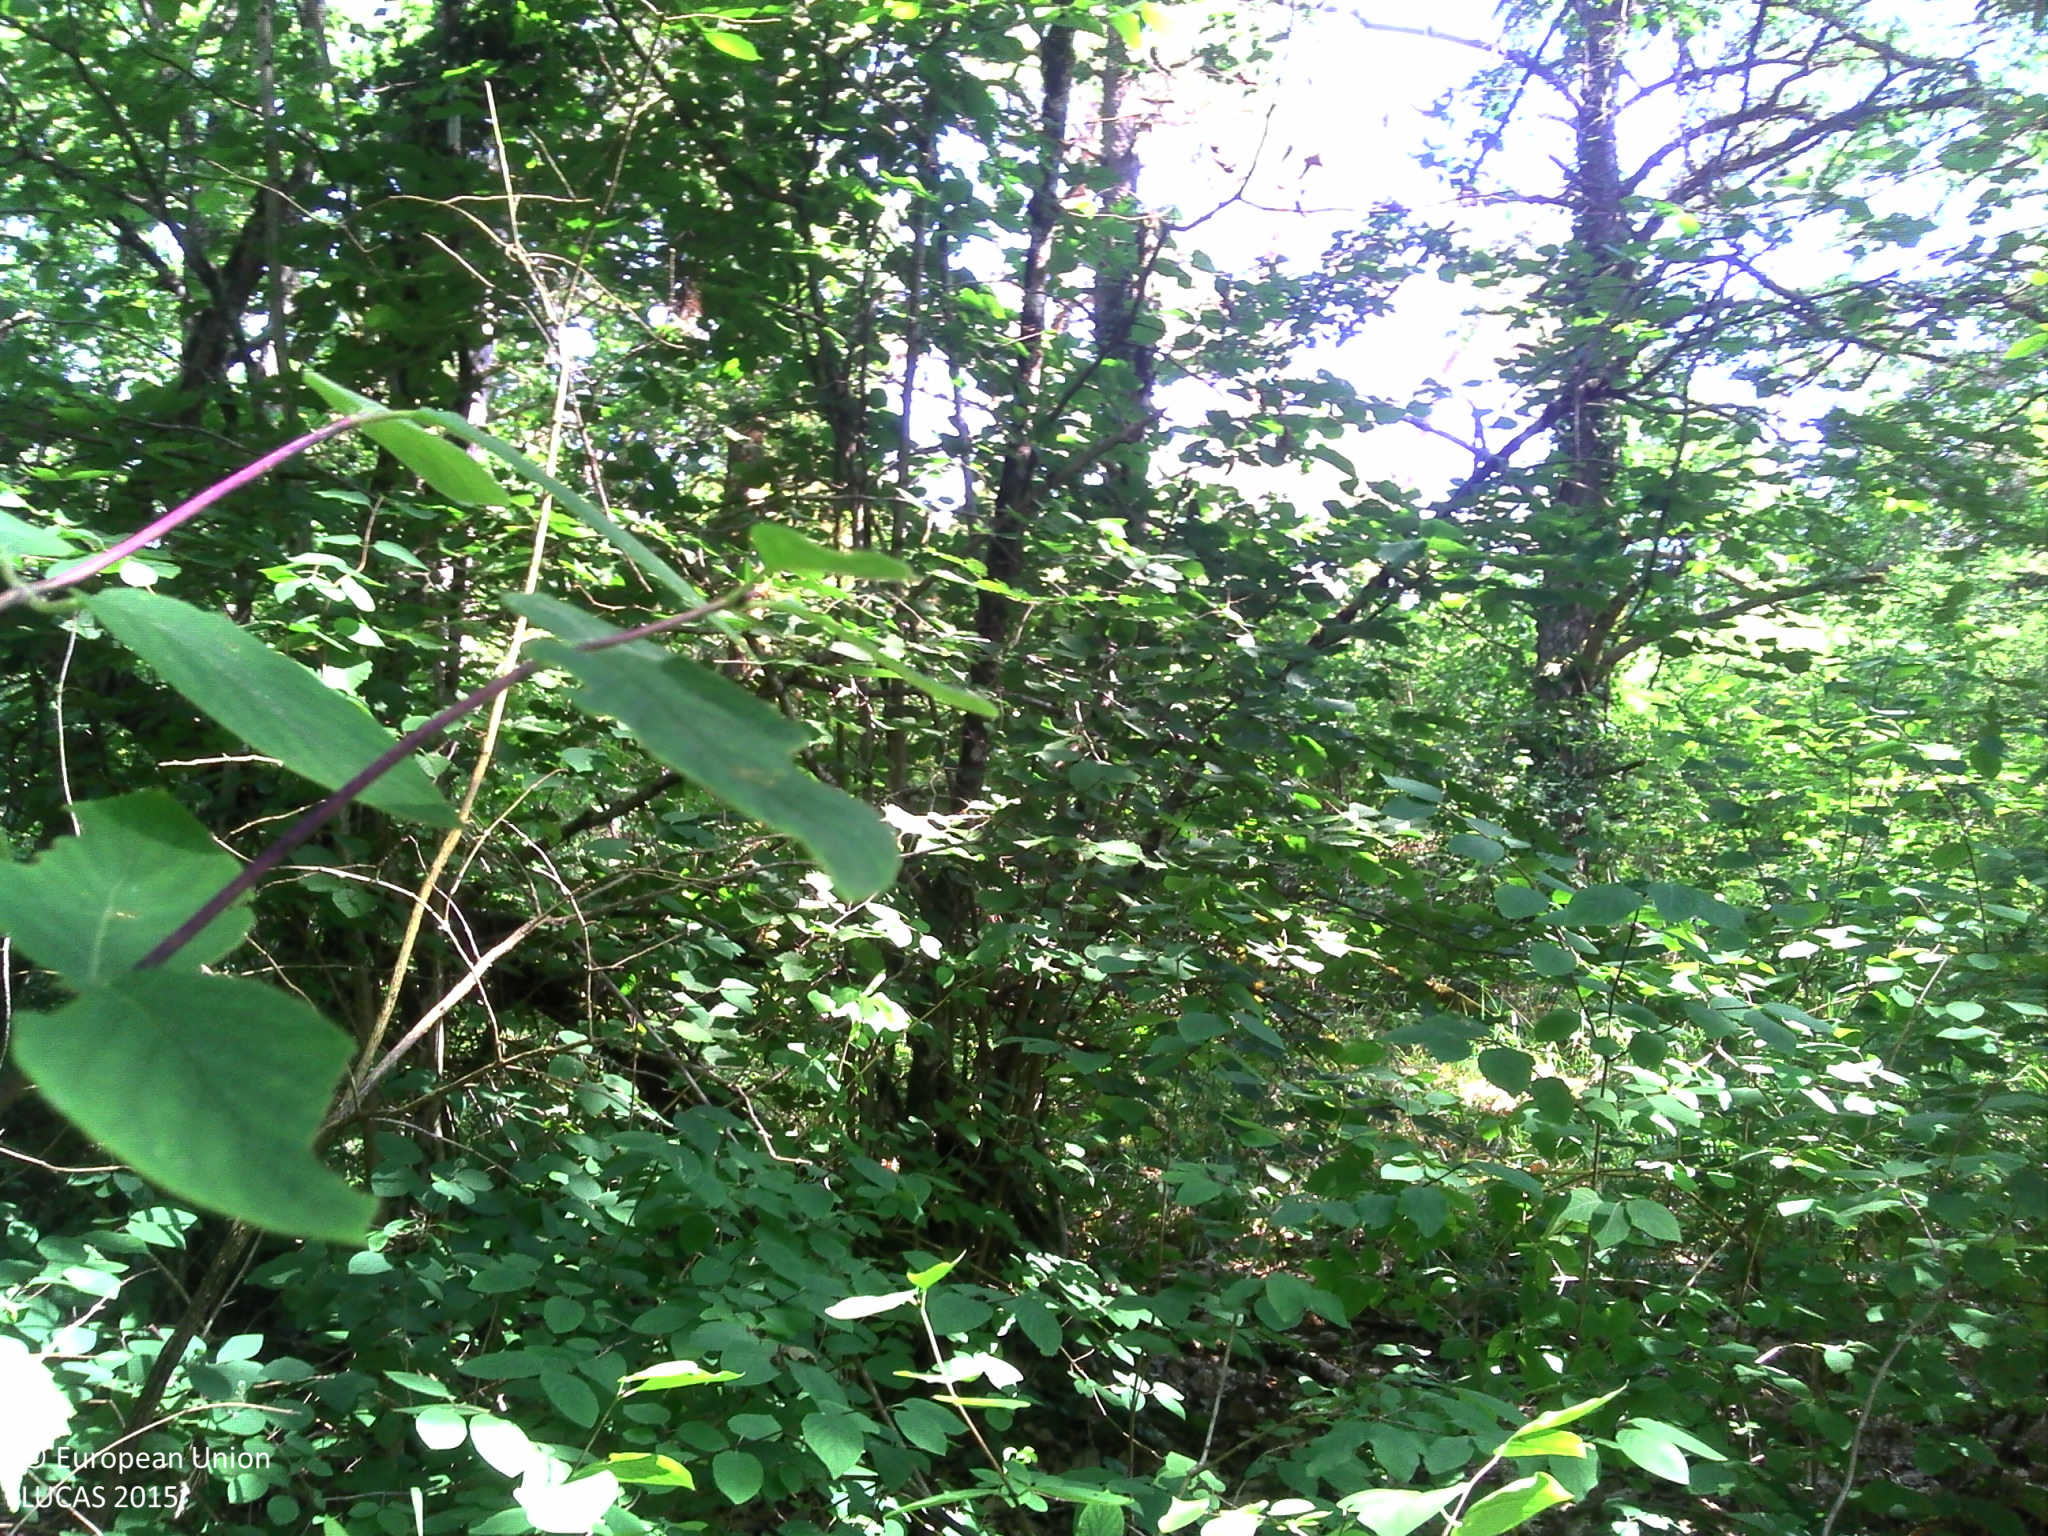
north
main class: Woodland
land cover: Broadleaved woodland
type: acidophilous oak and oak-birch forest
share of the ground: > 75 %
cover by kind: broadleaved forest trees 85 %, coniferous forest trees 5 %, herbaceous plants 5 %, lichens and mosses 5 %
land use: Forestry
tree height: > 5 m
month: June
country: FR
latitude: 48.2030
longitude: 5.0608
